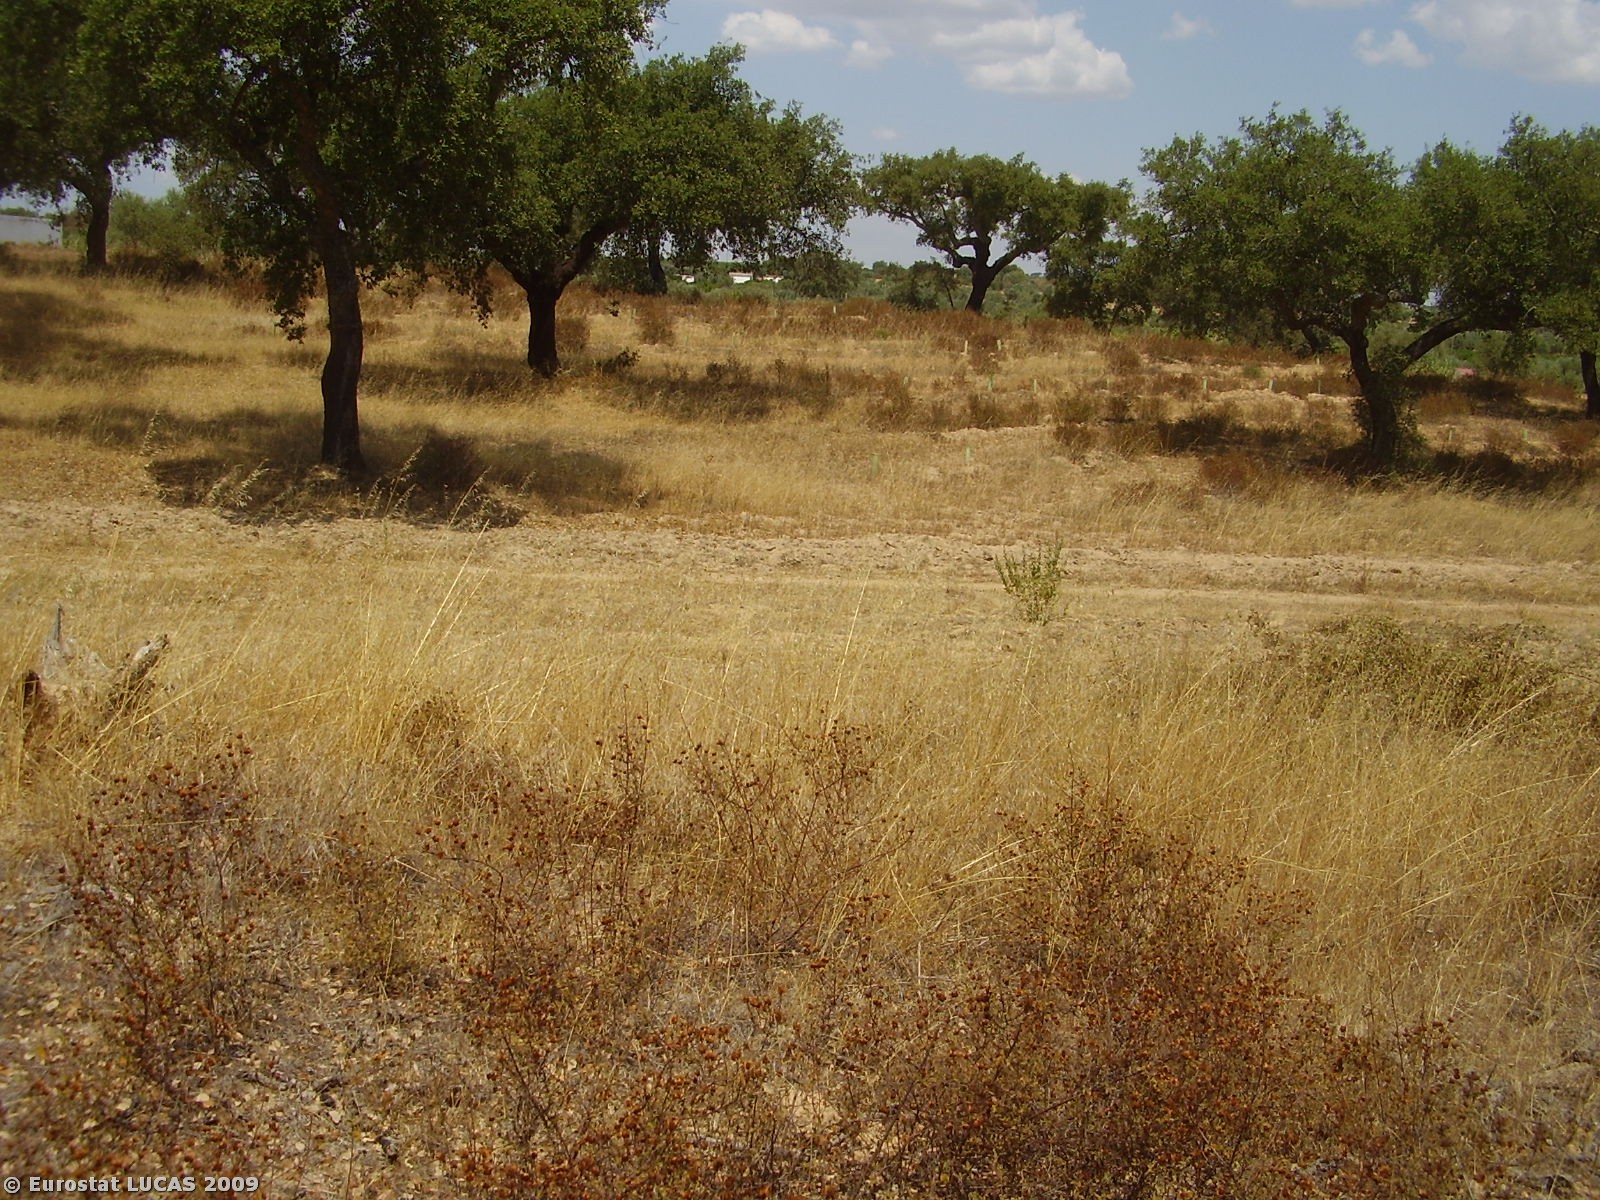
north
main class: Woodland
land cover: Broadleaved woodland
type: broadleaved evergreen forest
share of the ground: 25 - 50 %
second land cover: Shrubland with sparse tree cover
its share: 10 - 25 %
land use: Forestry
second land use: Fallow land
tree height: > 5 m
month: August
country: PT
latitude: 38.2071
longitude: -7.8583
